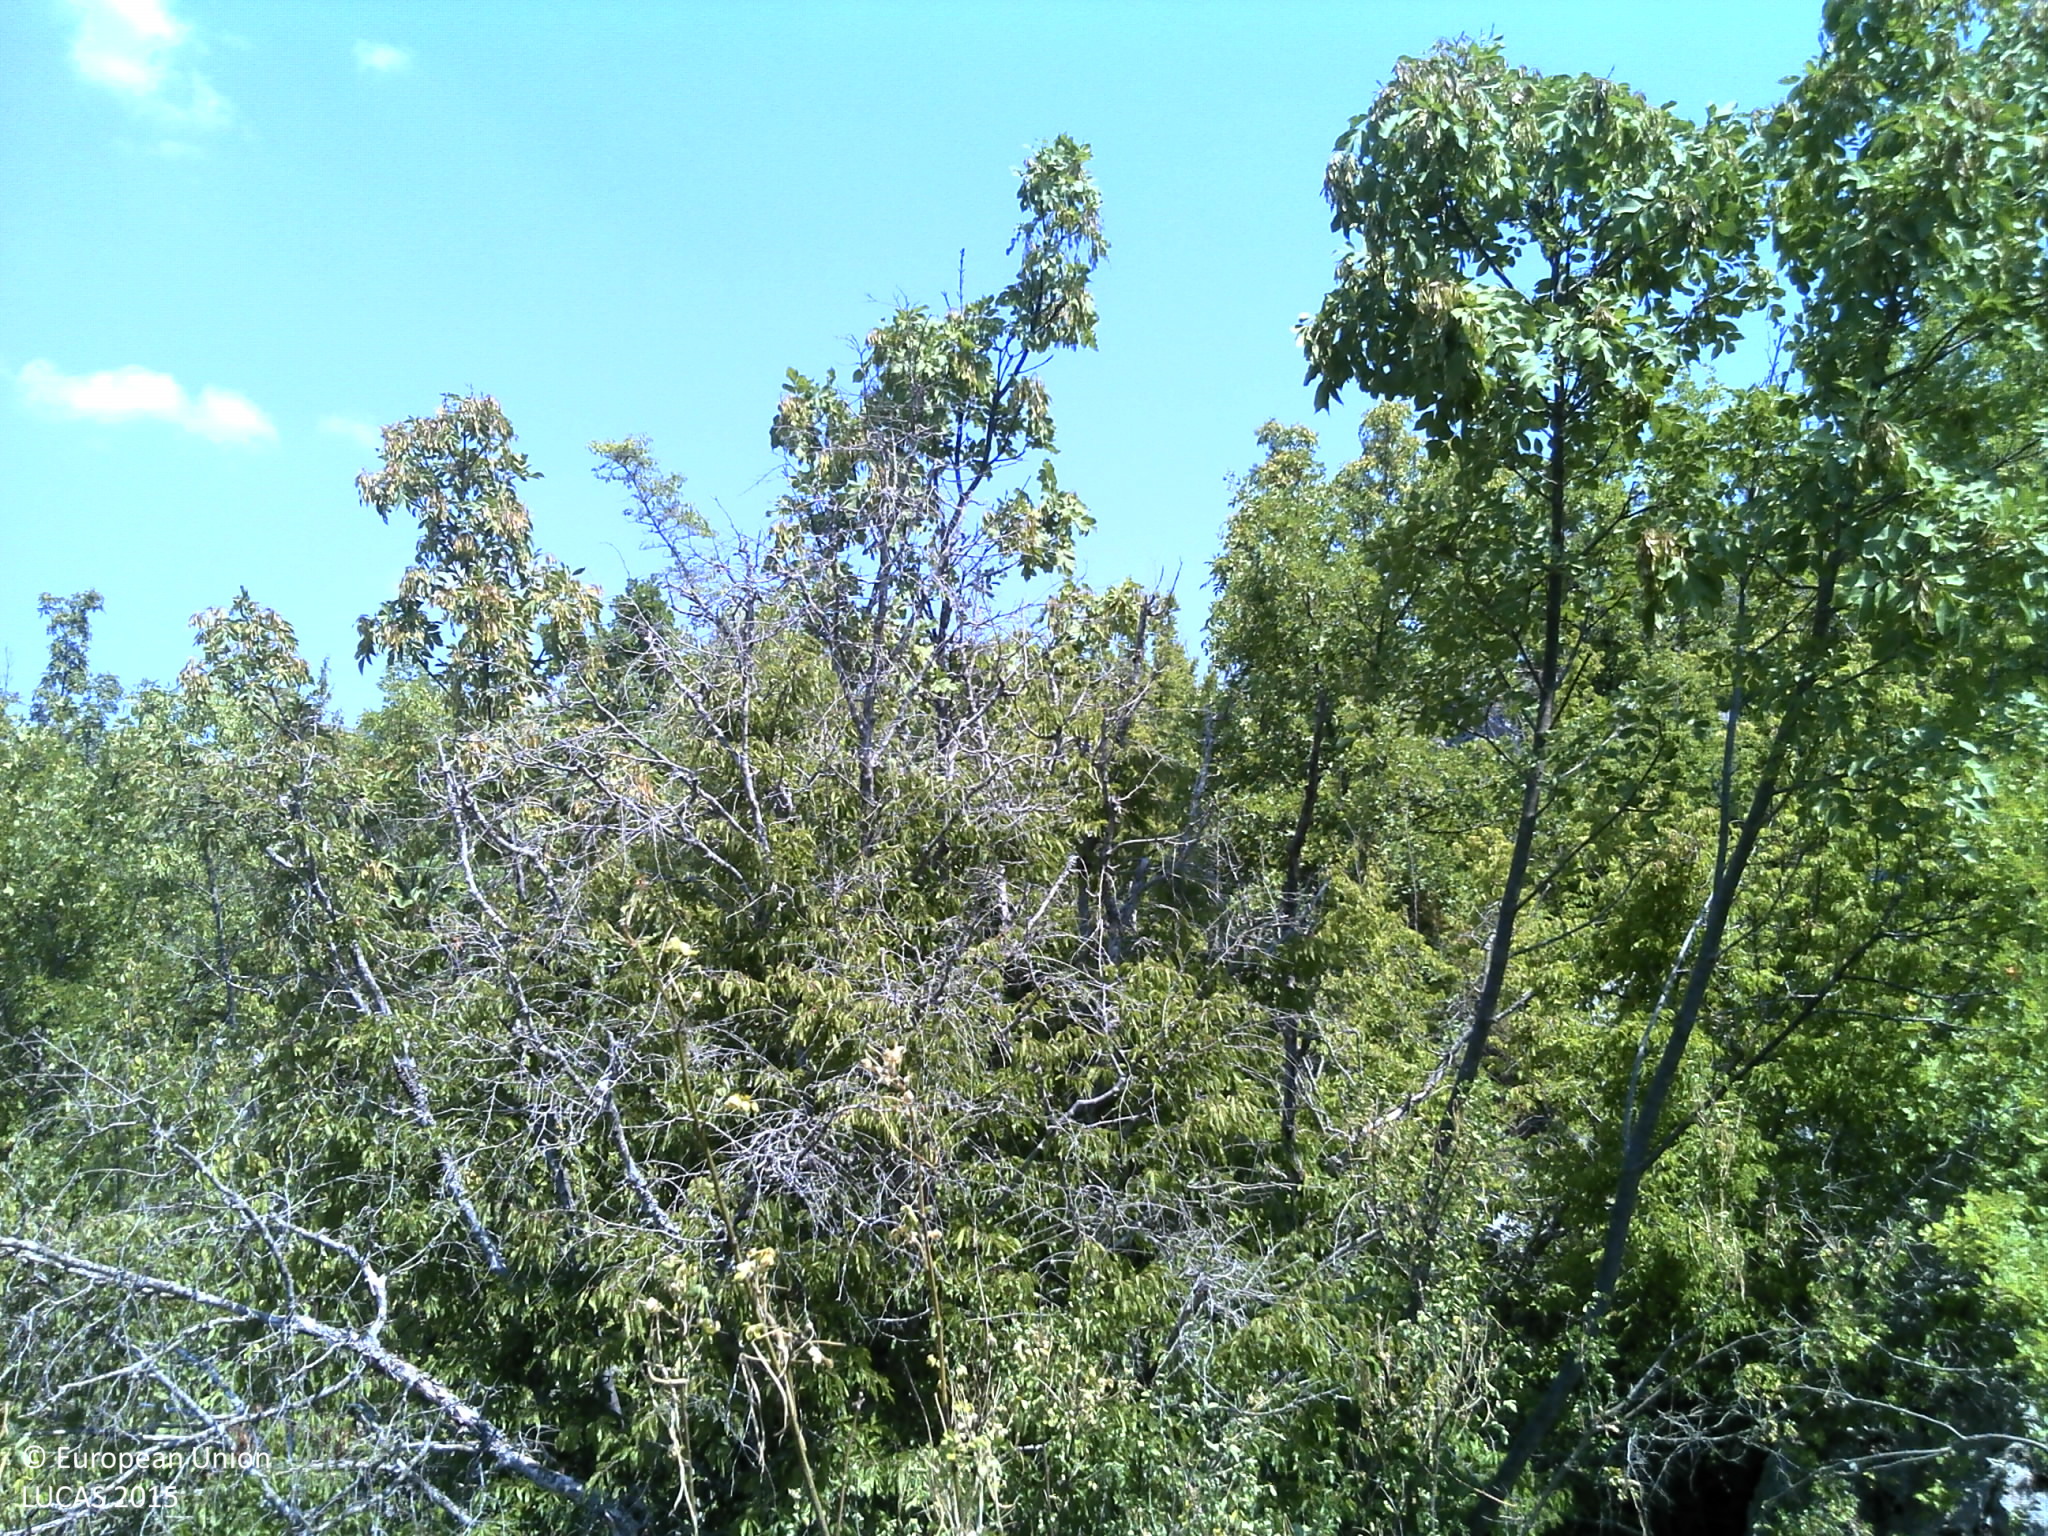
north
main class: Shrubland
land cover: Shrubland with sparse tree cover
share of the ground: > 75 %
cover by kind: shrubs 75 %, consolidated bare surface 10 %, broadleaved forest trees 5 %, herbaceous plants 5 %, unconsolidated bare surface 5 %
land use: Semi-natural and natural areas not in use
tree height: > 5 m
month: July
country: HR
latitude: 43.4624
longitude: 16.9995
